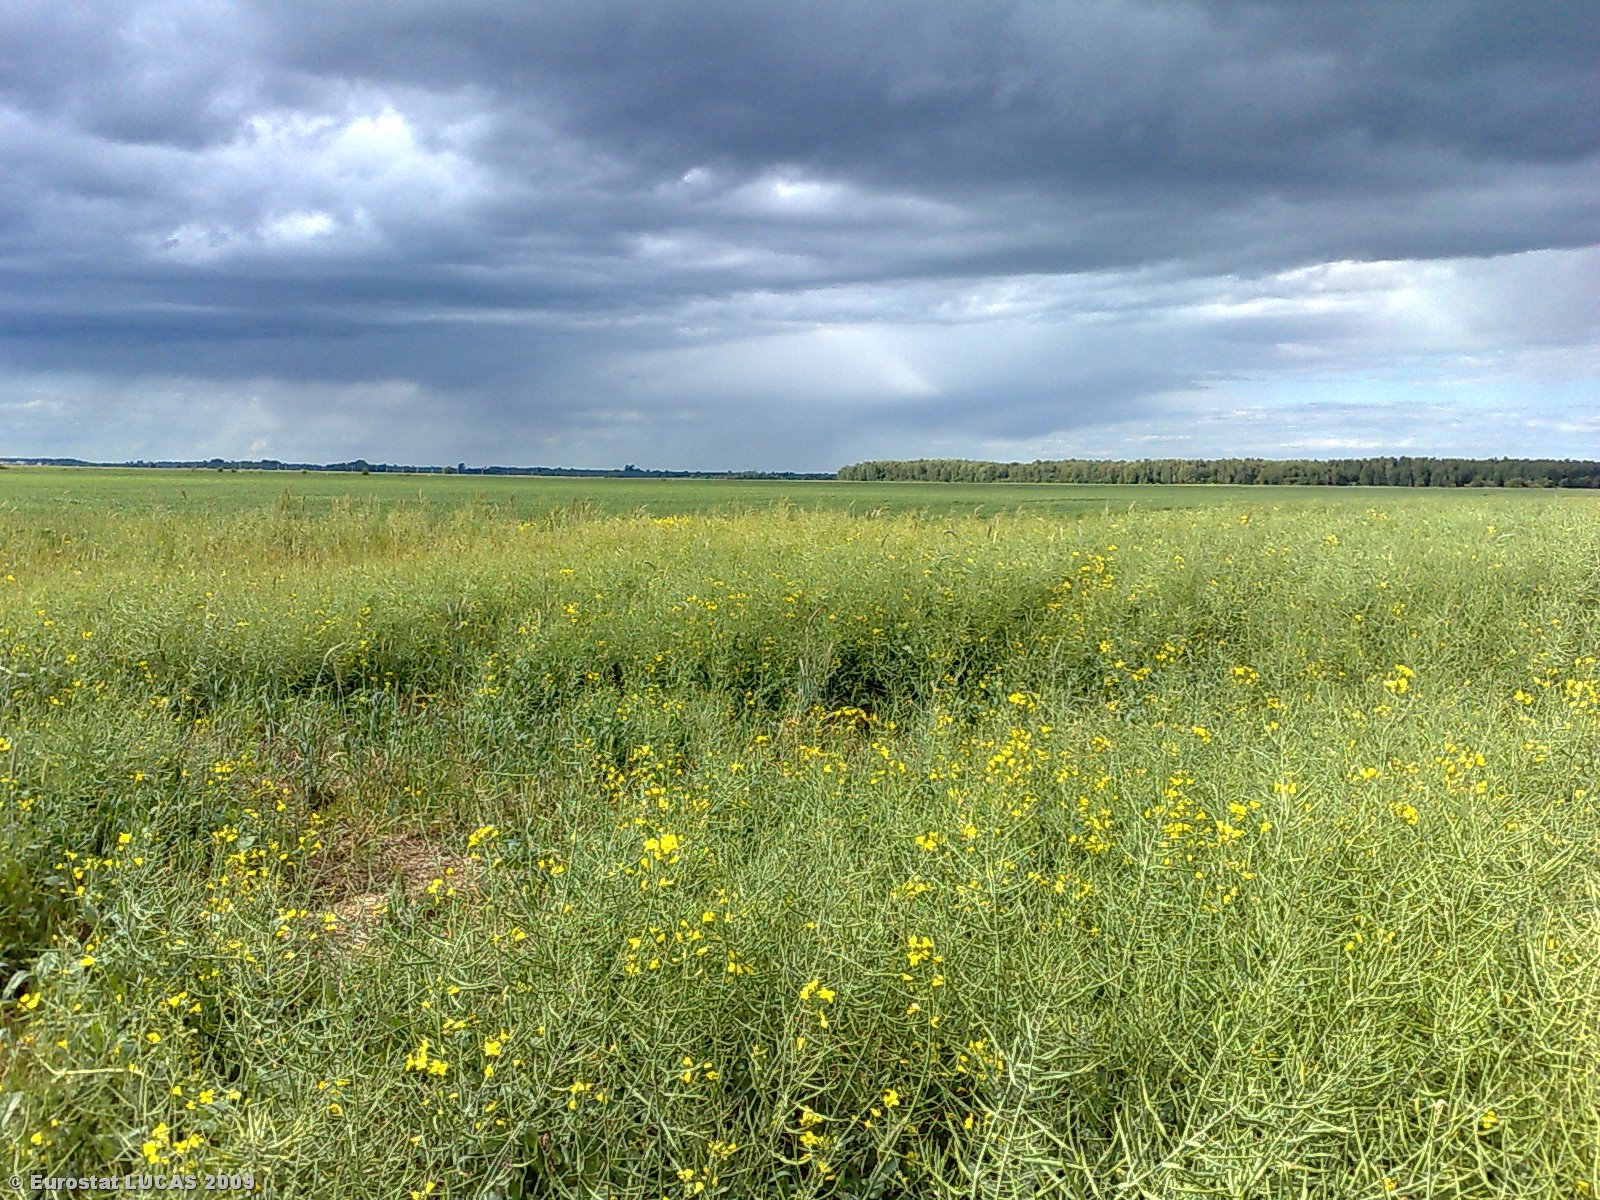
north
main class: Cropland
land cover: Rape and turnip rape
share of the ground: > 75 %
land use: Agriculture (excluding fallow land and kitchen gardens)
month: June
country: LT
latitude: 56.0116
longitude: 23.8951
